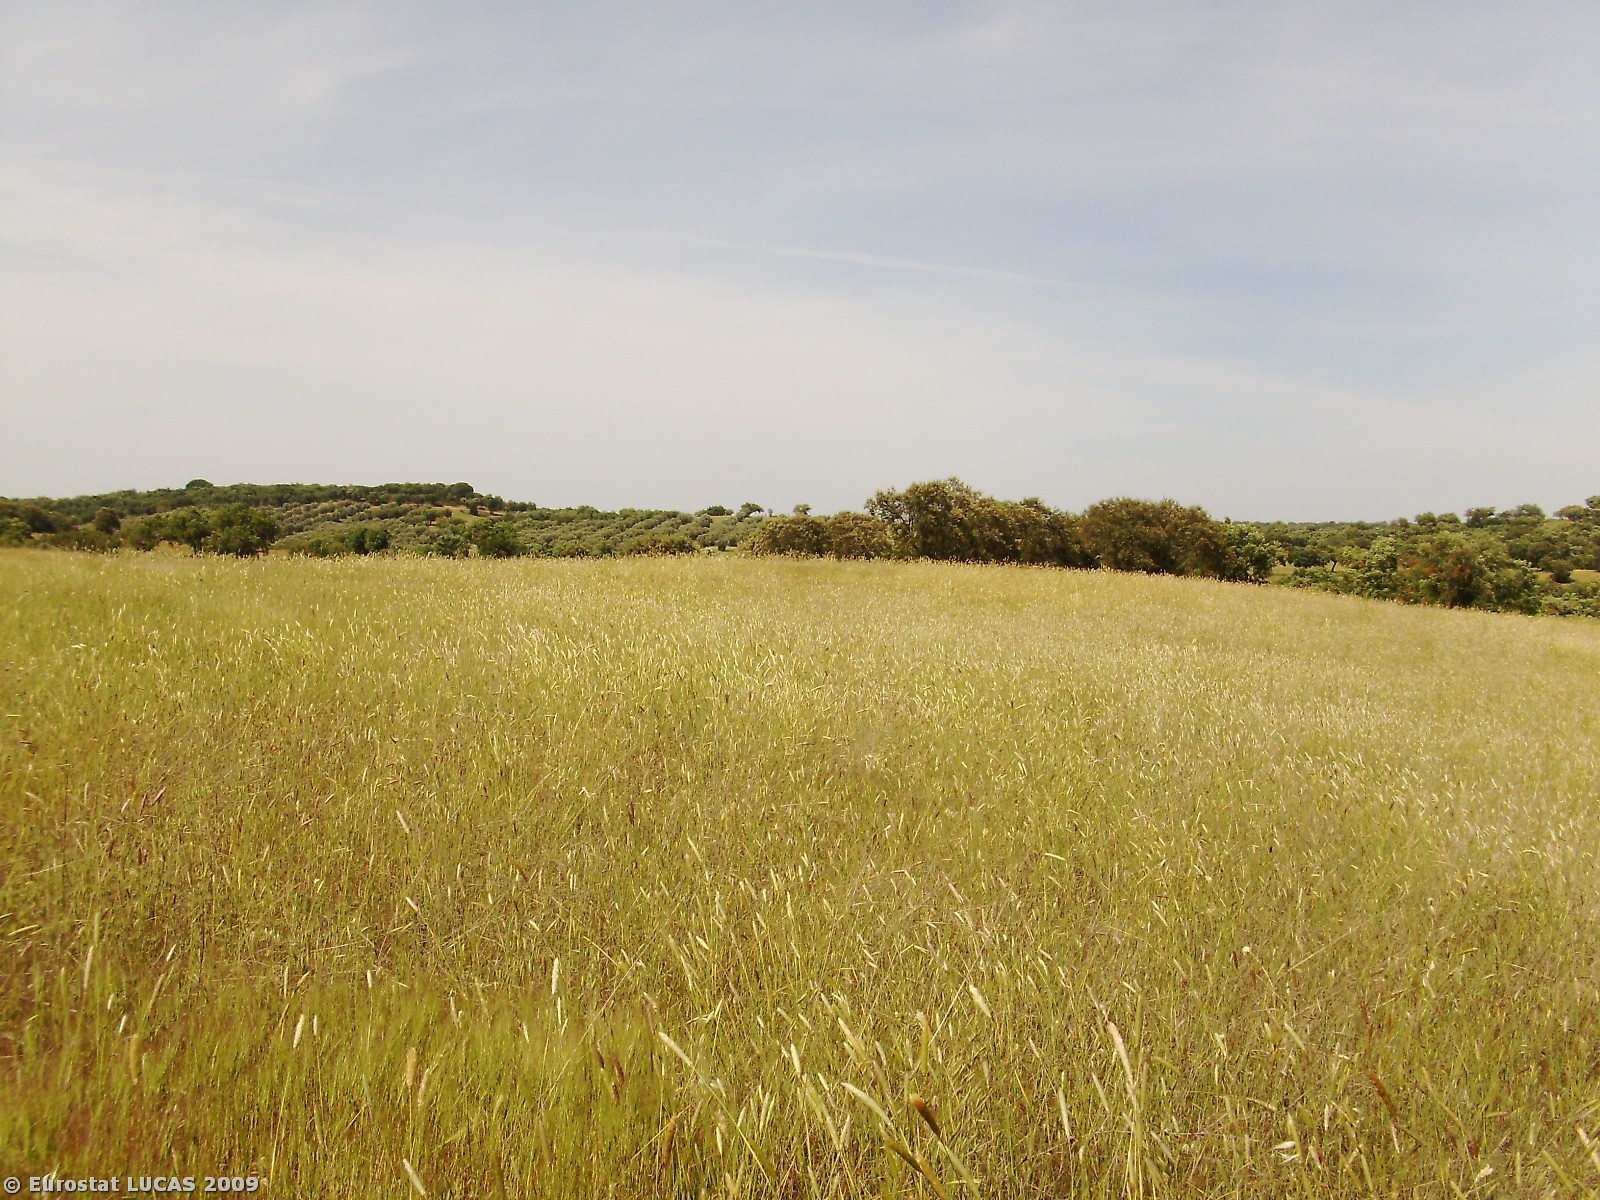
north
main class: Grassland
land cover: Grassland with sparse tree/shrub cover
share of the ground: > 75 %
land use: Agriculture (excluding fallow land and kitchen gardens)
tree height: > 5 m
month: May
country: PT
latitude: 38.9669
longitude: -8.0433
